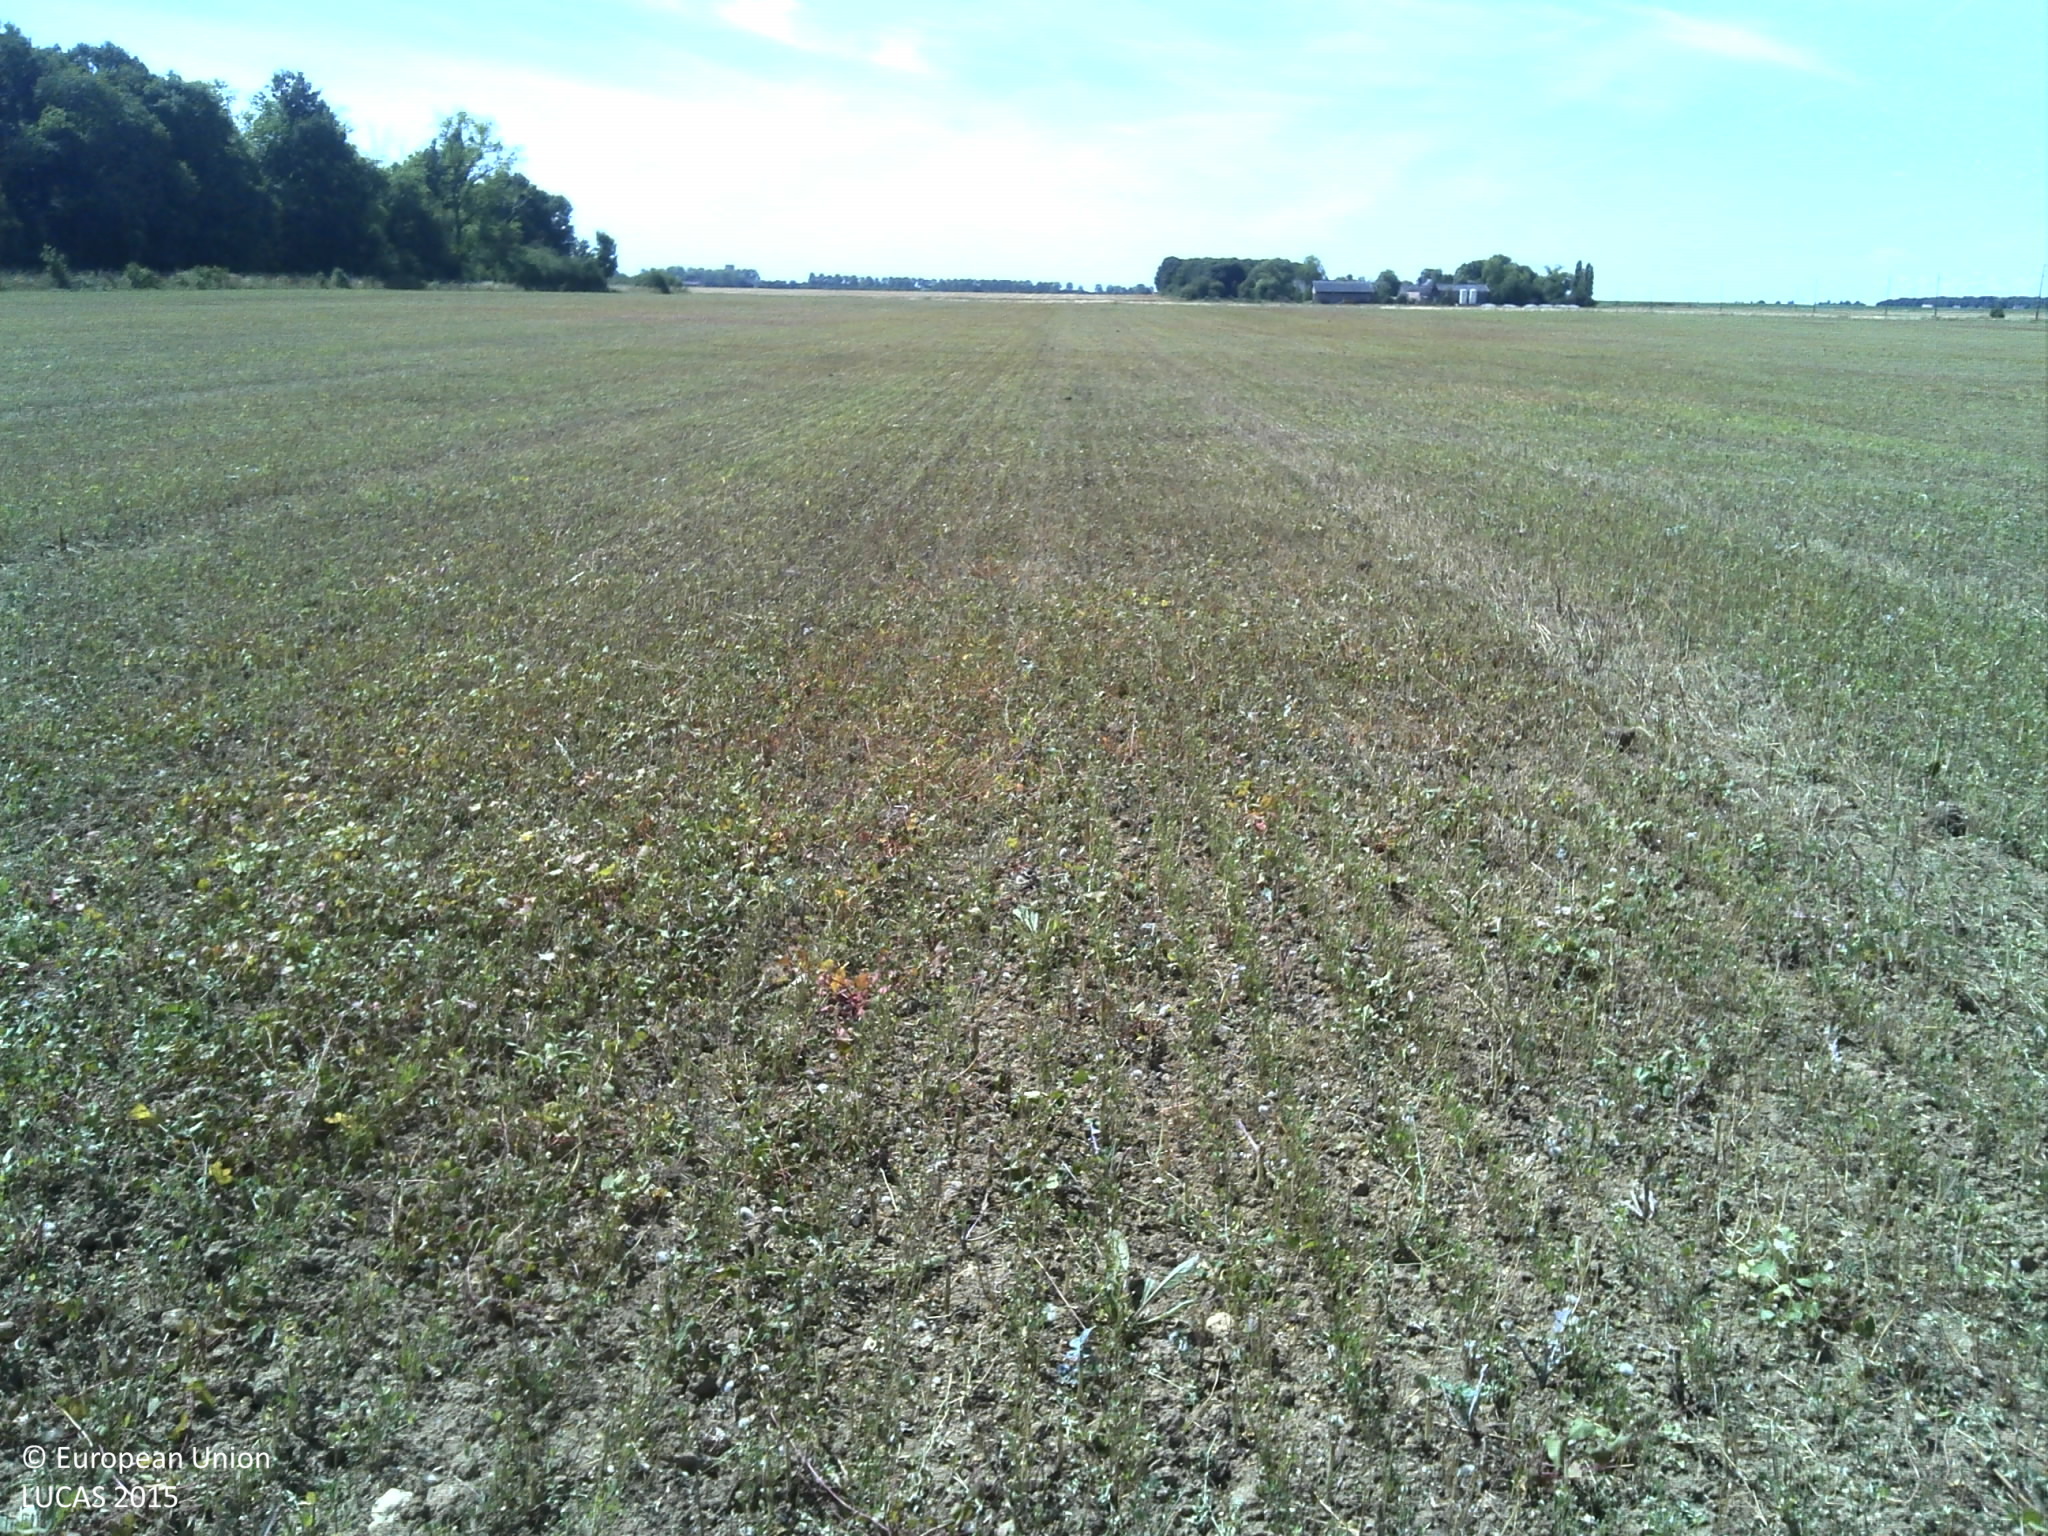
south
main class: Cropland
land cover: Temporary grasslands
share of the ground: > 75 %
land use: Agriculture (excluding fallow land and kitchen gardens)
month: July
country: FR
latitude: 48.5558
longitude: 1.8699
